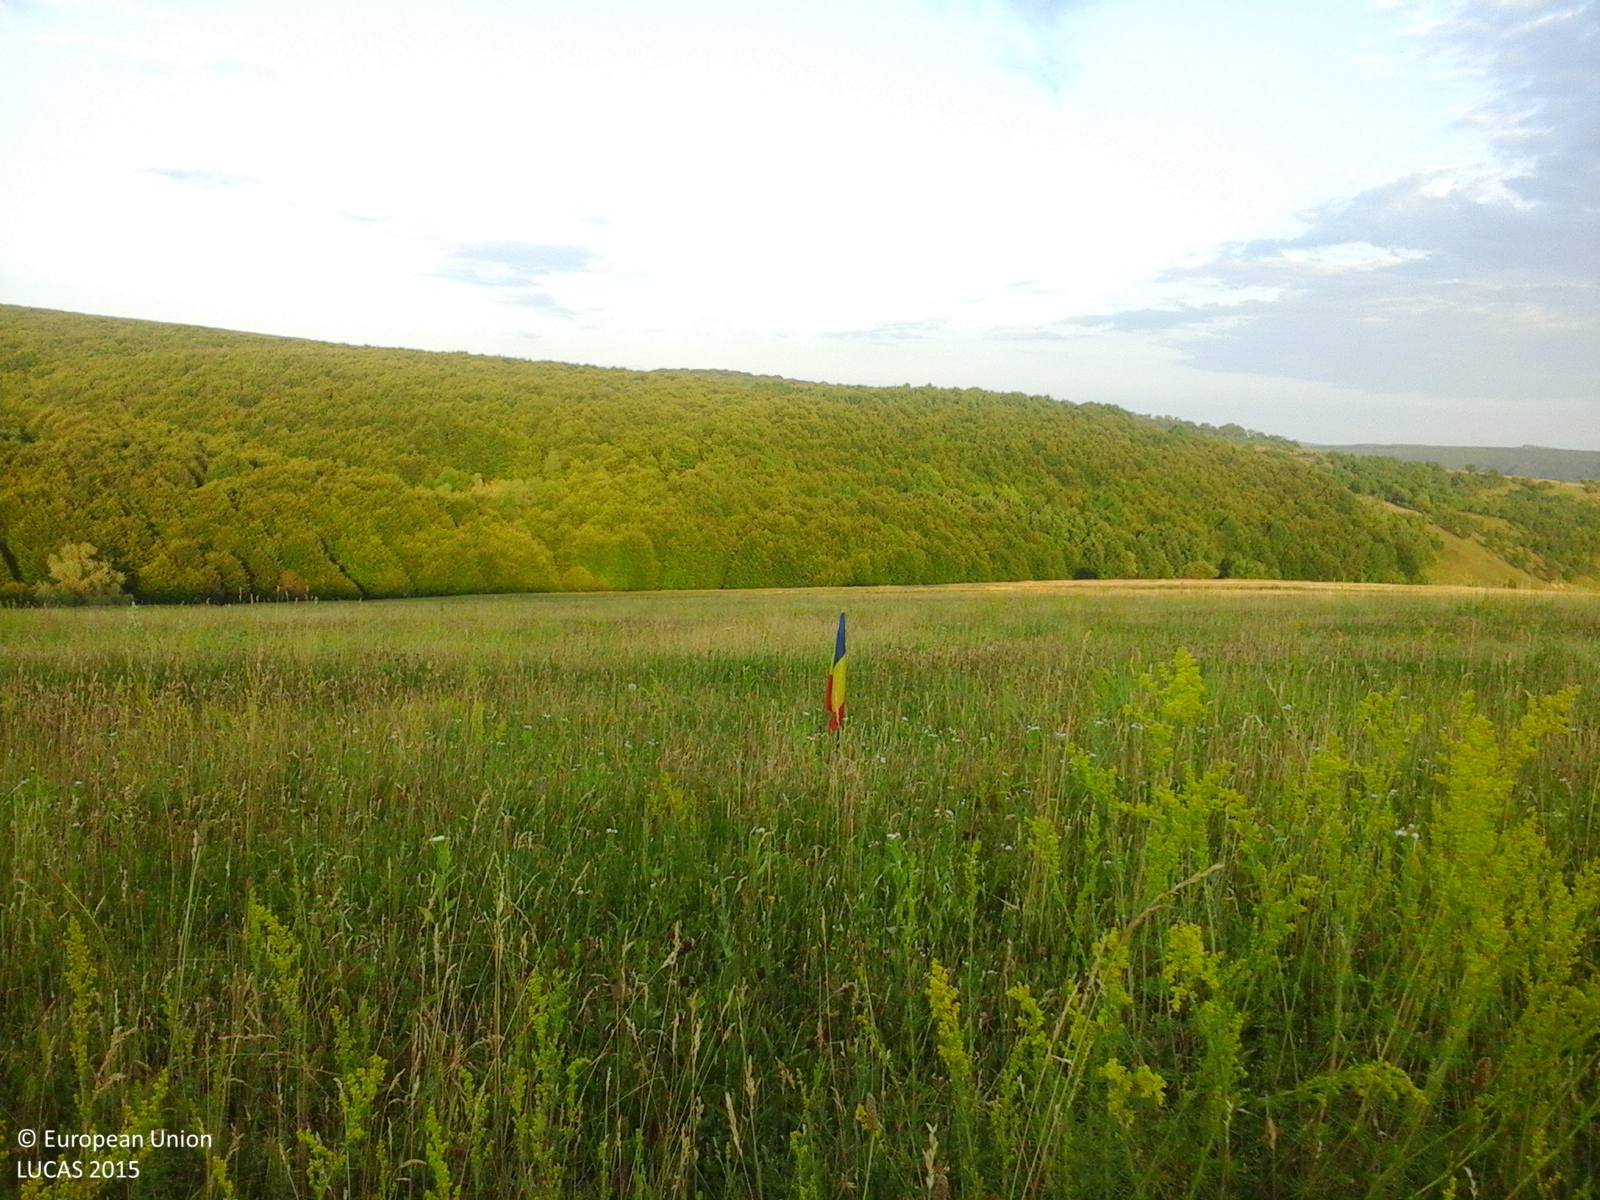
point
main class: Grassland
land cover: Grassland without tree/shrub cover
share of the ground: > 75 %
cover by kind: herbaceous plants 100 %
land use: Agriculture (excluding fallow land and kitchen gardens)
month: June
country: RO
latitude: 47.4607
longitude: 26.5251
